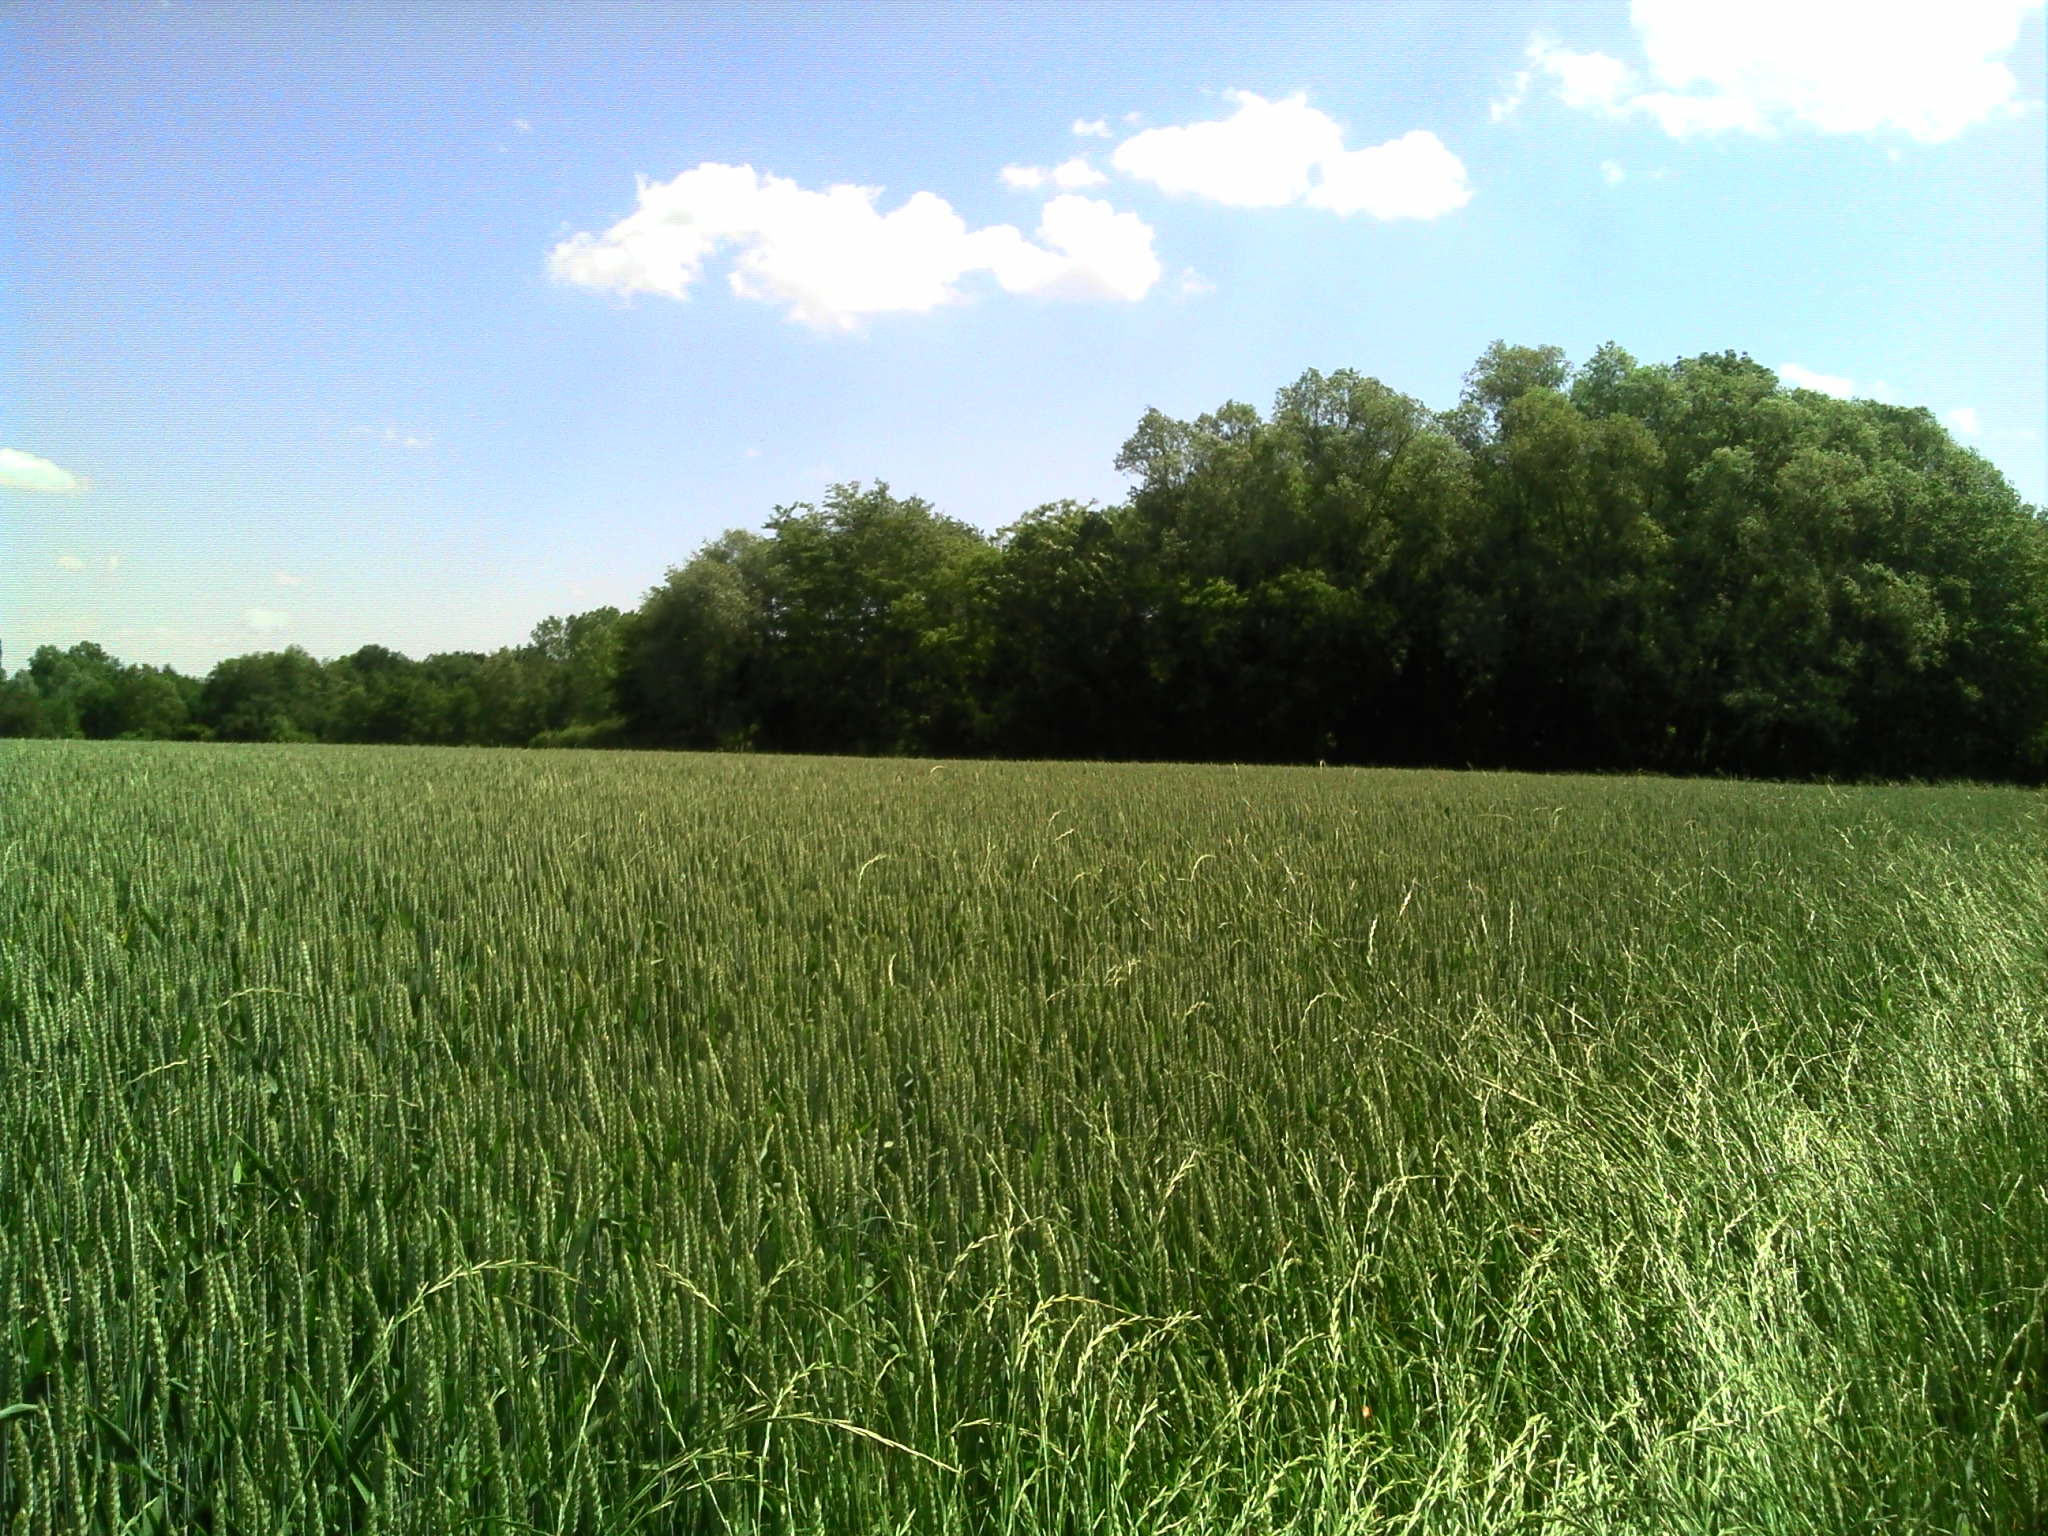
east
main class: Cropland
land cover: Common wheat
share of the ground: > 75 %
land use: Agriculture (excluding fallow land and kitchen gardens)
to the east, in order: Common wheat; Grass margins; Paved roads, cycling and walking lanes; Grass margins; Broadleaved woodland; Maize; Other bare soil; Maize
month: May
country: FR
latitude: 46.5761
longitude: 4.9783
